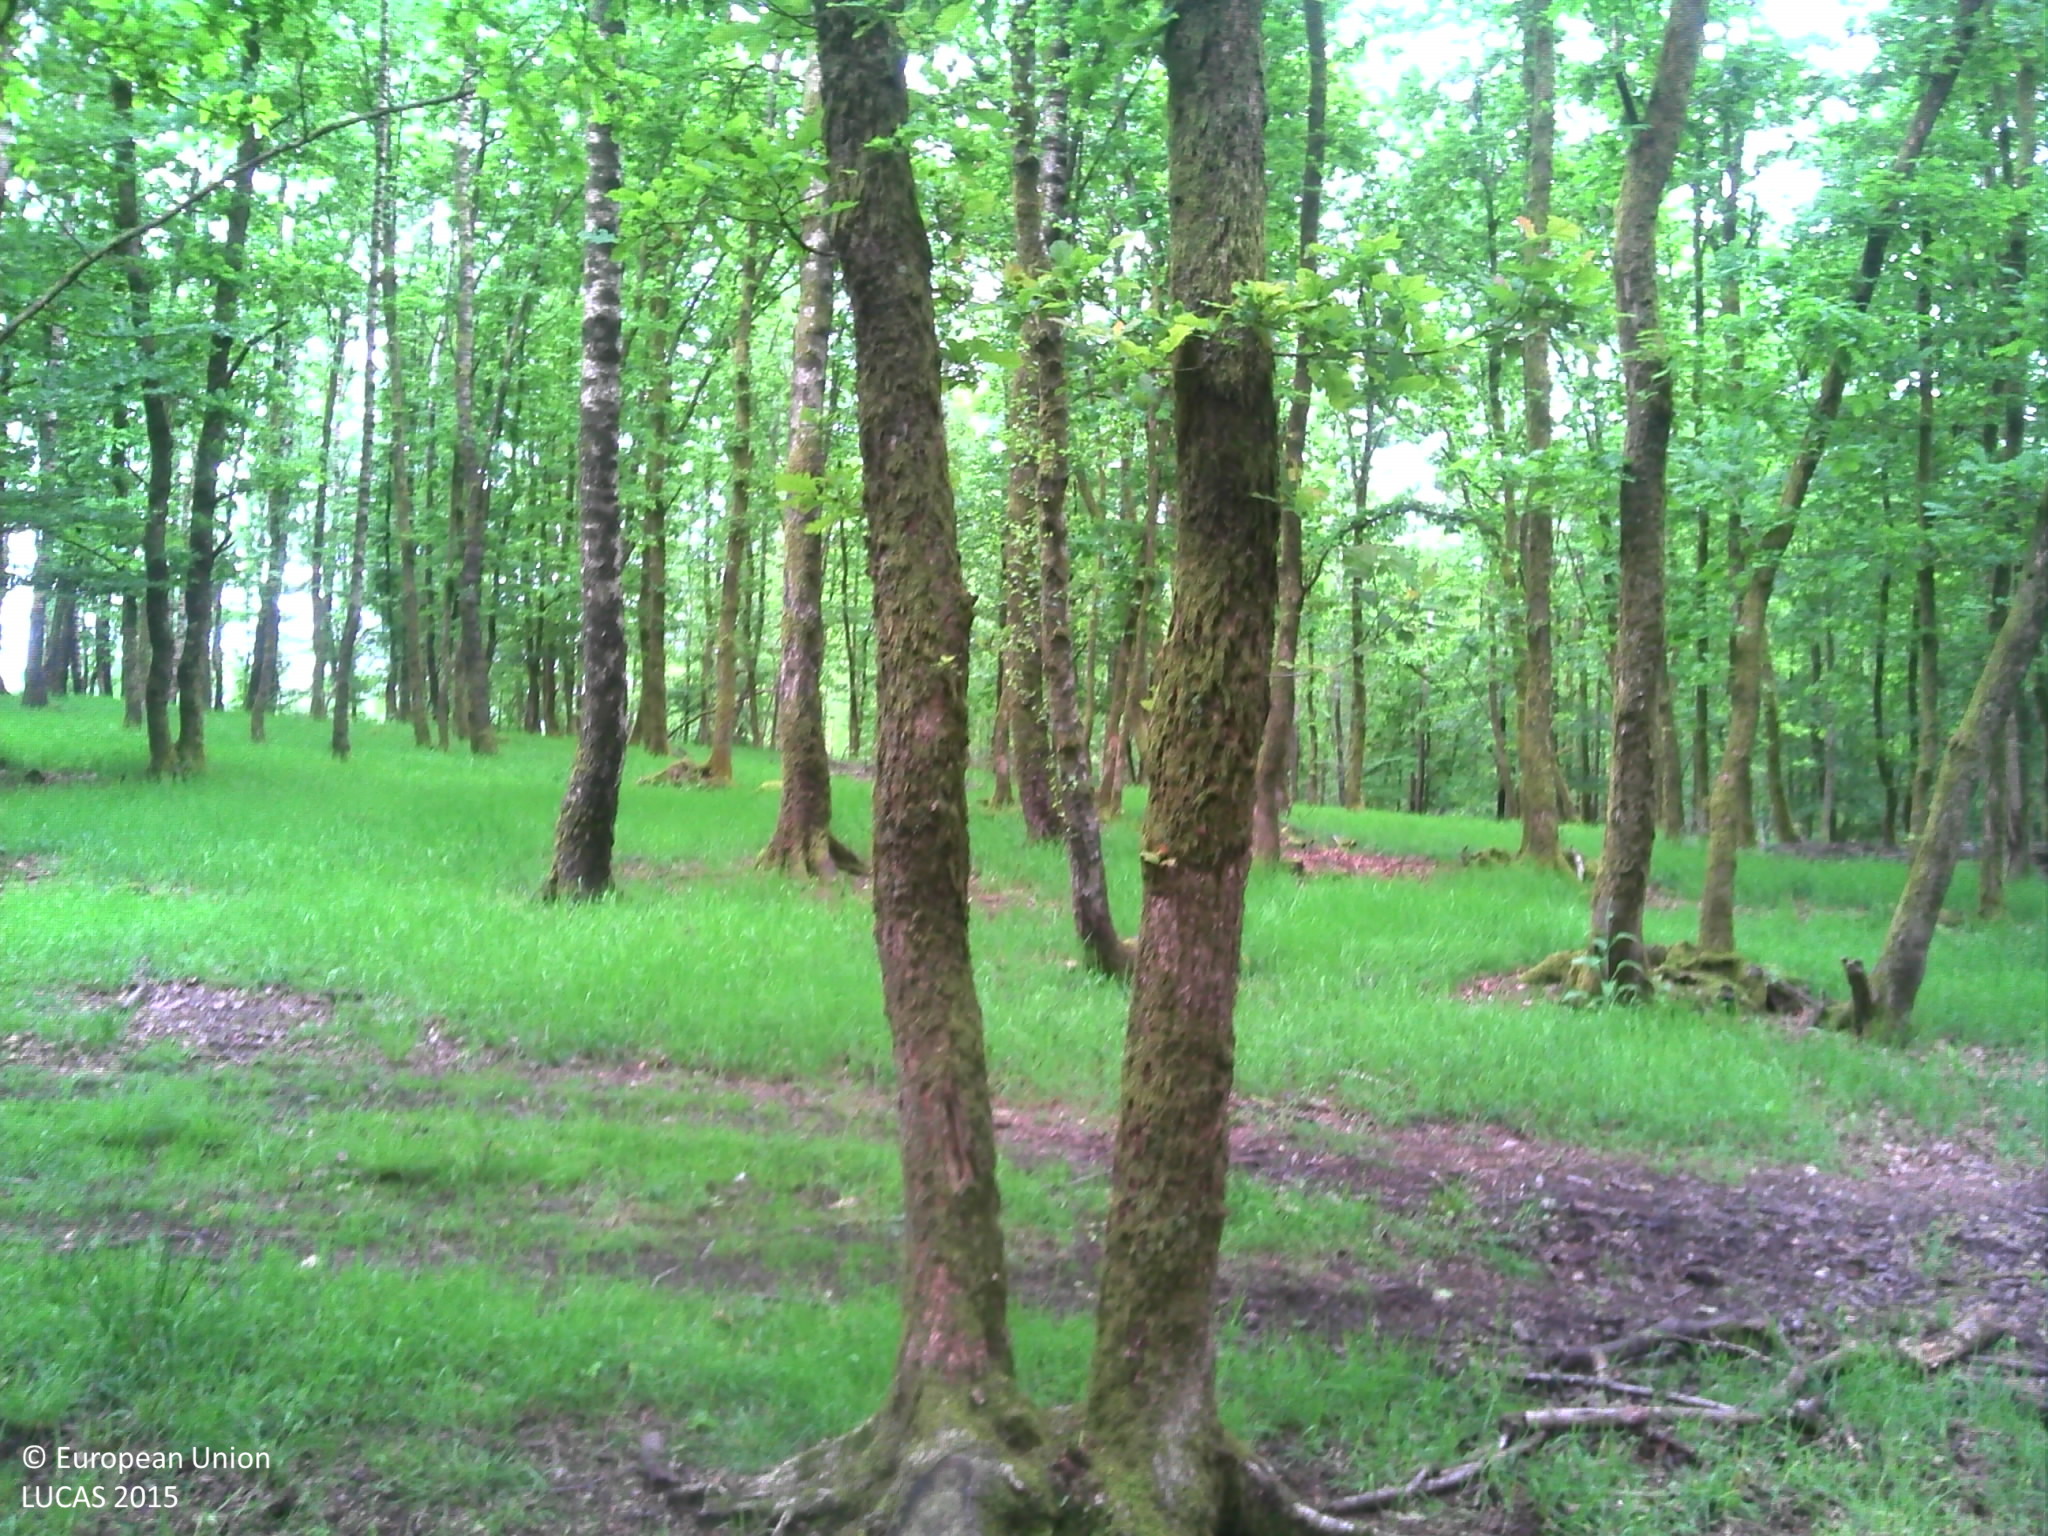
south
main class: Woodland
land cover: Broadleaved woodland
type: acidophilous oak and oak-birch forest
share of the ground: > 75 %
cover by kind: broadleaved forest trees 85 %, herbaceous plants 10 %, unconsolidated bare surface 5 %
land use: Forestry
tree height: > 5 m
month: June
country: BE
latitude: 49.8190
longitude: 4.9241
